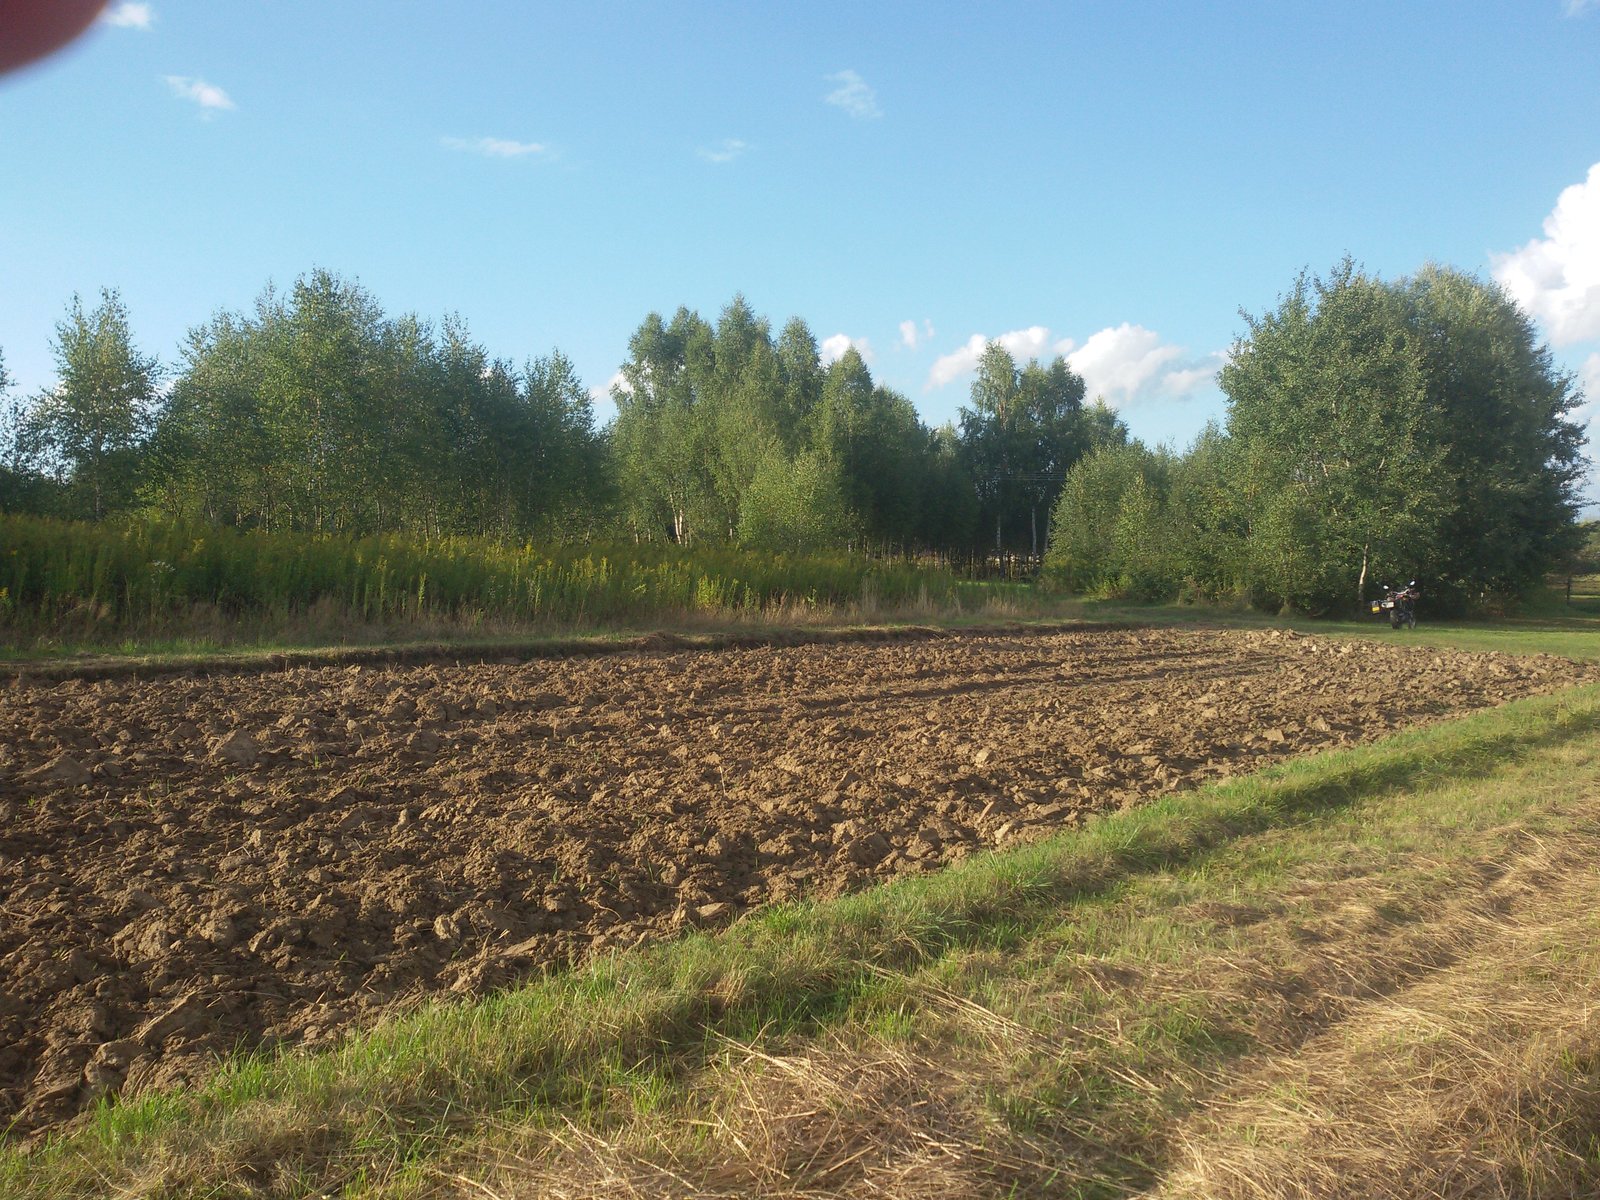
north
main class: Grassland
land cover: Grassland without tree/shrub cover
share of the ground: > 75 %
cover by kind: herbaceous plants 100 %
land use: Agriculture (excluding fallow land and kitchen gardens)
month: September
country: PL
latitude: 49.6802
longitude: 21.4271
